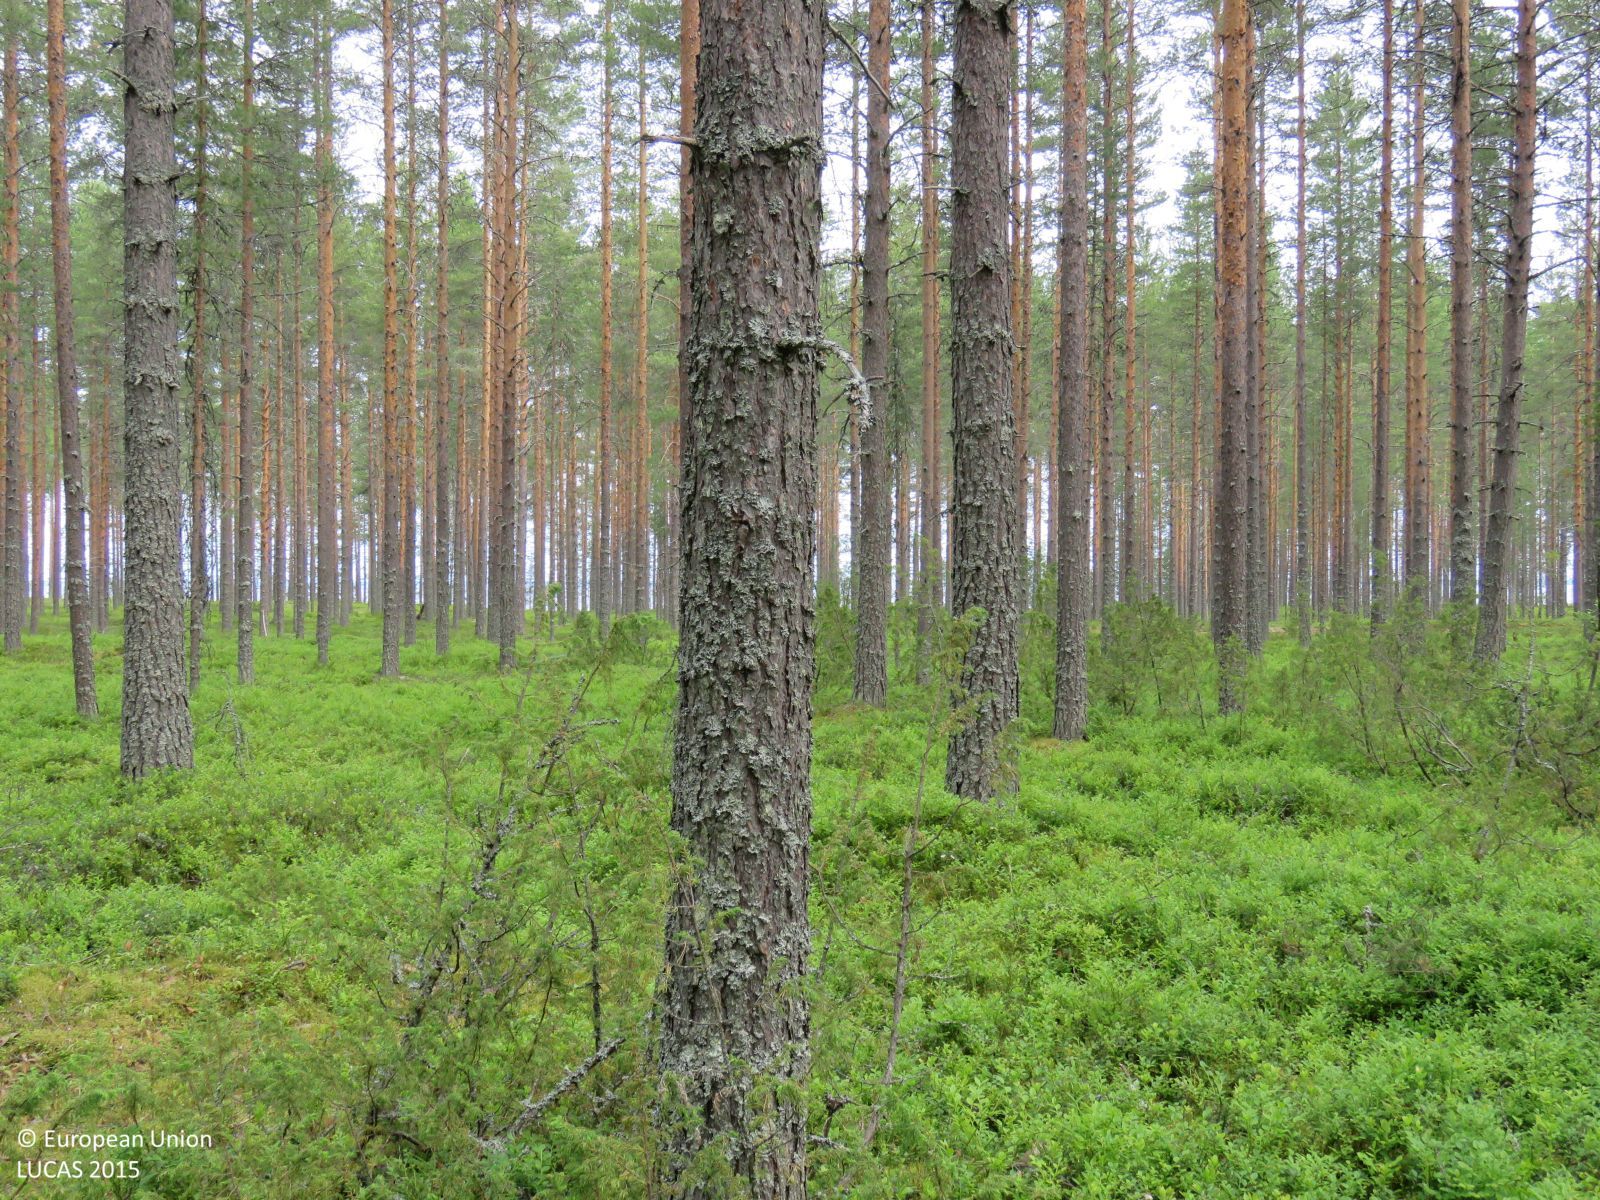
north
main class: Woodland
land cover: Pine dominated coniferous woodland
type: boreal forest
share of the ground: 50 - 75 %
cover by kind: coniferous forest trees 70 %, shrubs 25 %, lichens and mosses 5 %
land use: Forestry
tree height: > 5 m
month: July
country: FI
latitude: 64.4301
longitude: 26.8837
